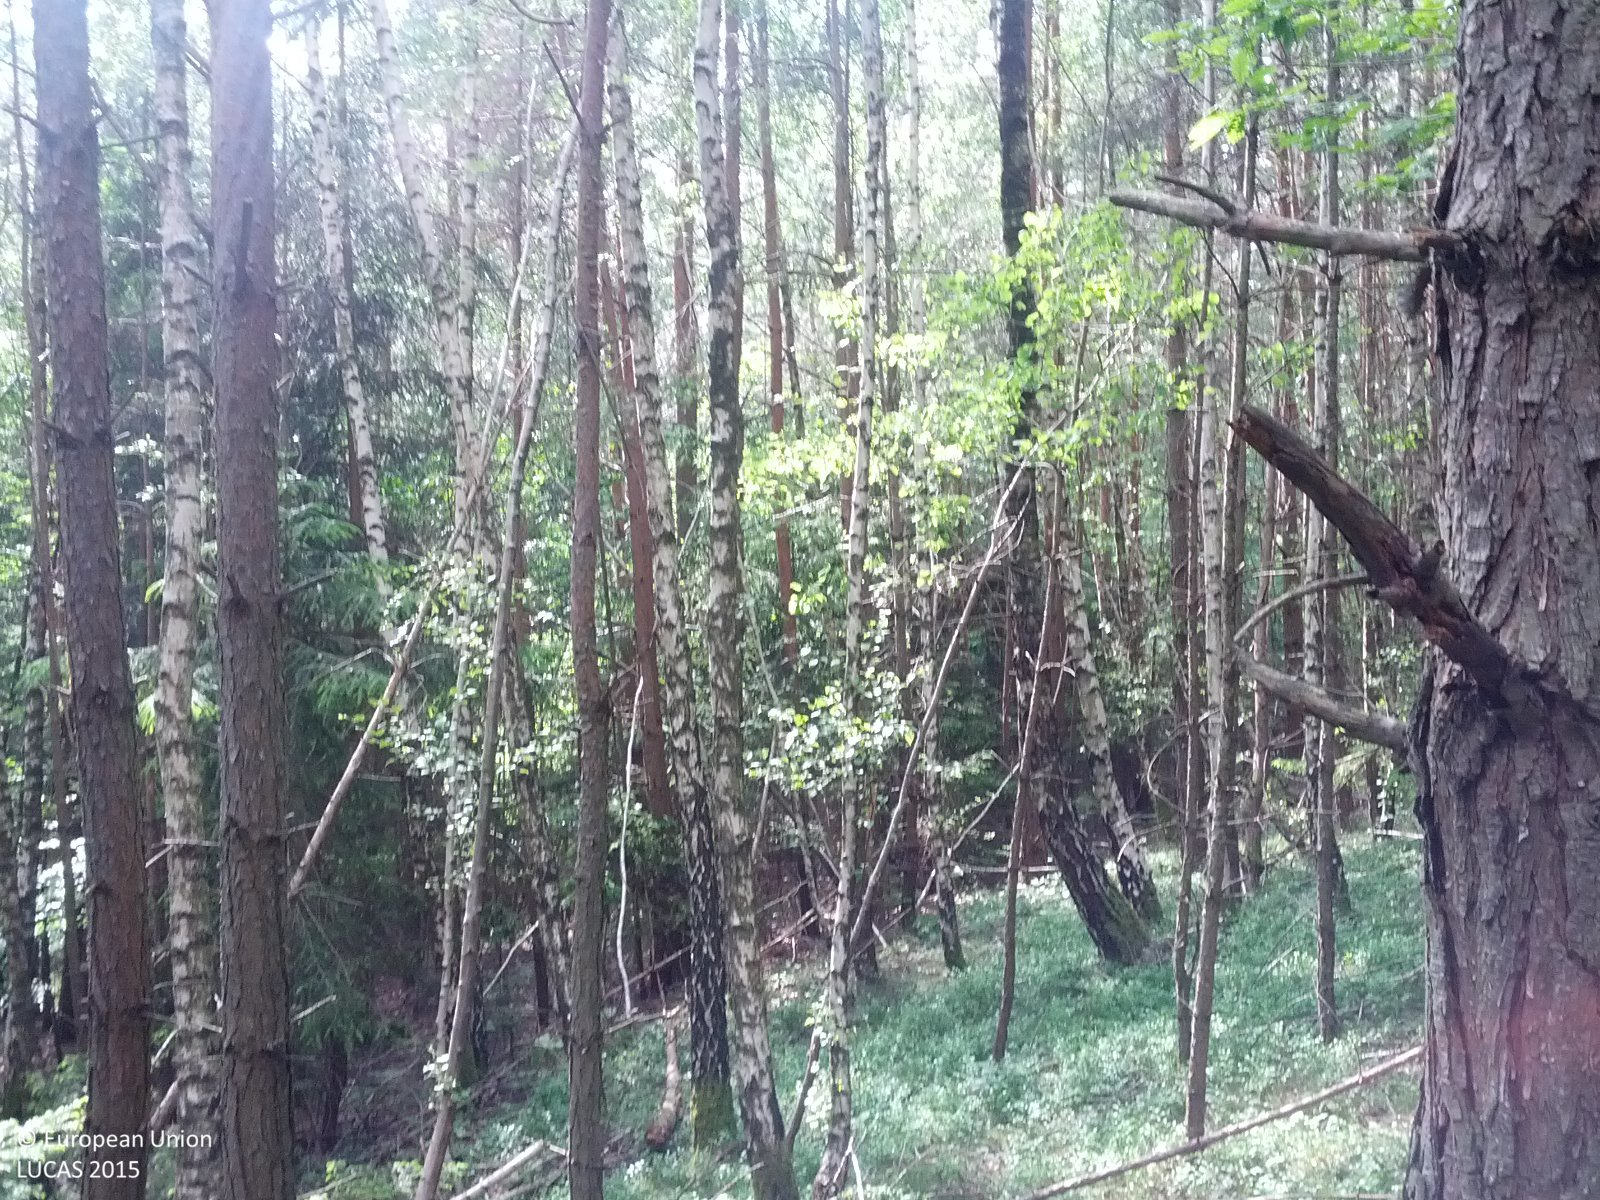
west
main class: Woodland
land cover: Pine dominated mixed woodland
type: boreal forest
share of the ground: > 75 %
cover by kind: coniferous forest trees 50 %, broadleaved forest trees 25 %, shrubs 20 %, herbaceous plants 5 %
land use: Forestry
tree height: > 5 m
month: May
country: AT
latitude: 47.4013
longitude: 16.1639
